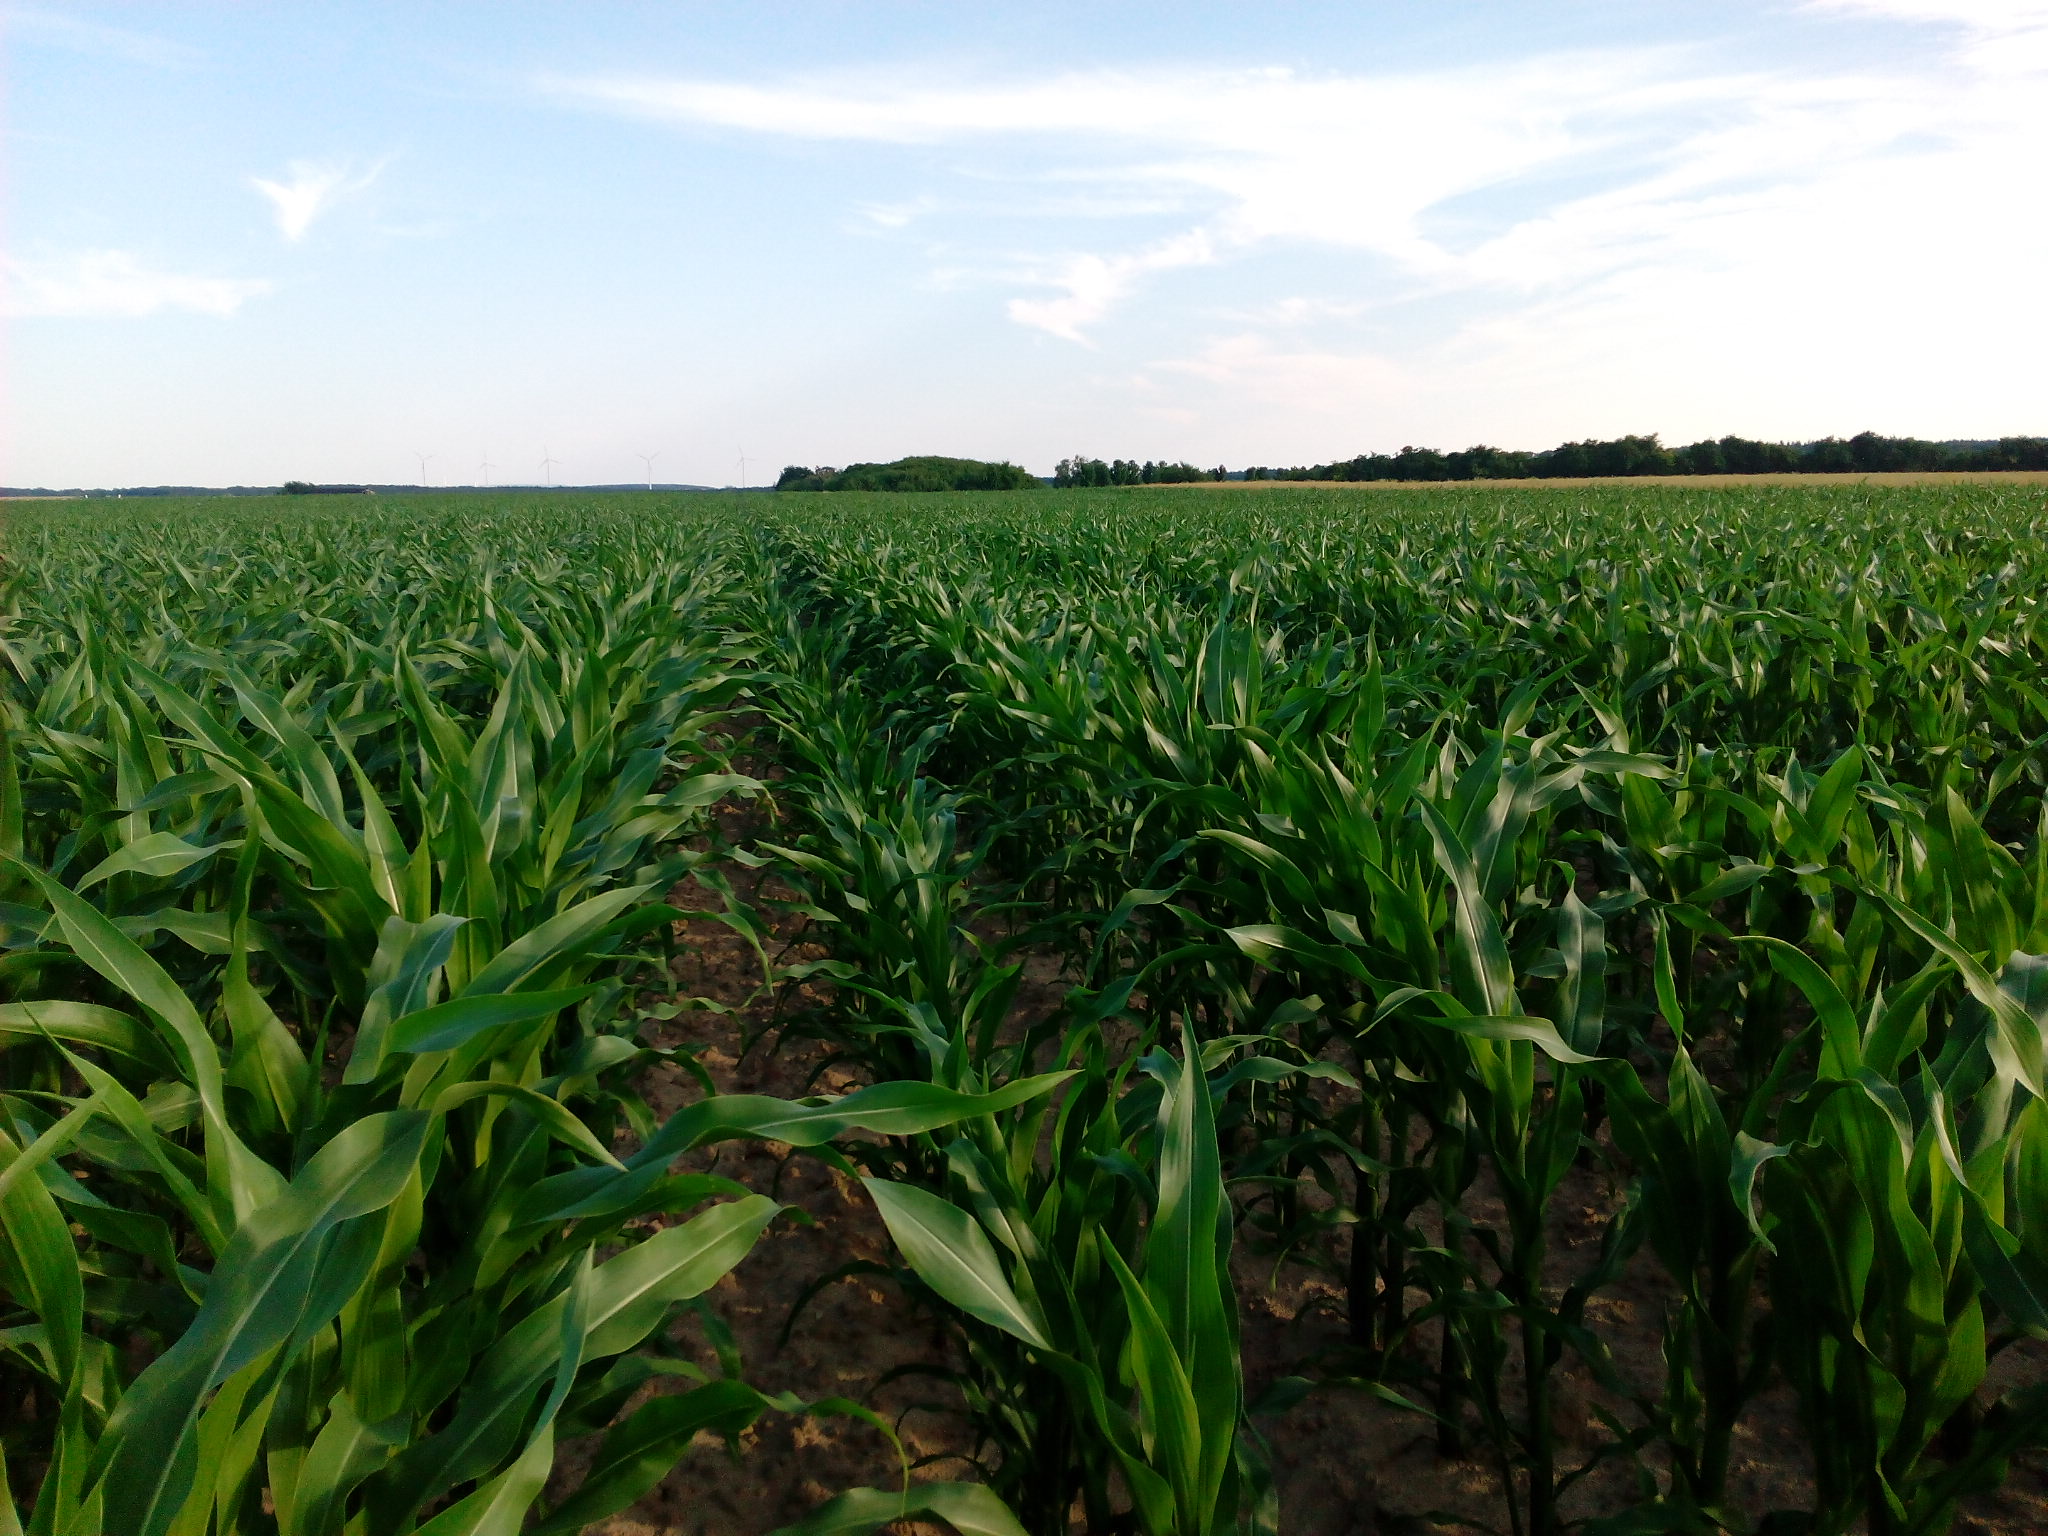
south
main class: Cropland
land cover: Maize
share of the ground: 50 - 75 %
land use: Agriculture (excluding fallow land and kitchen gardens)
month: July
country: DE
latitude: 53.2219
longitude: 14.1794
